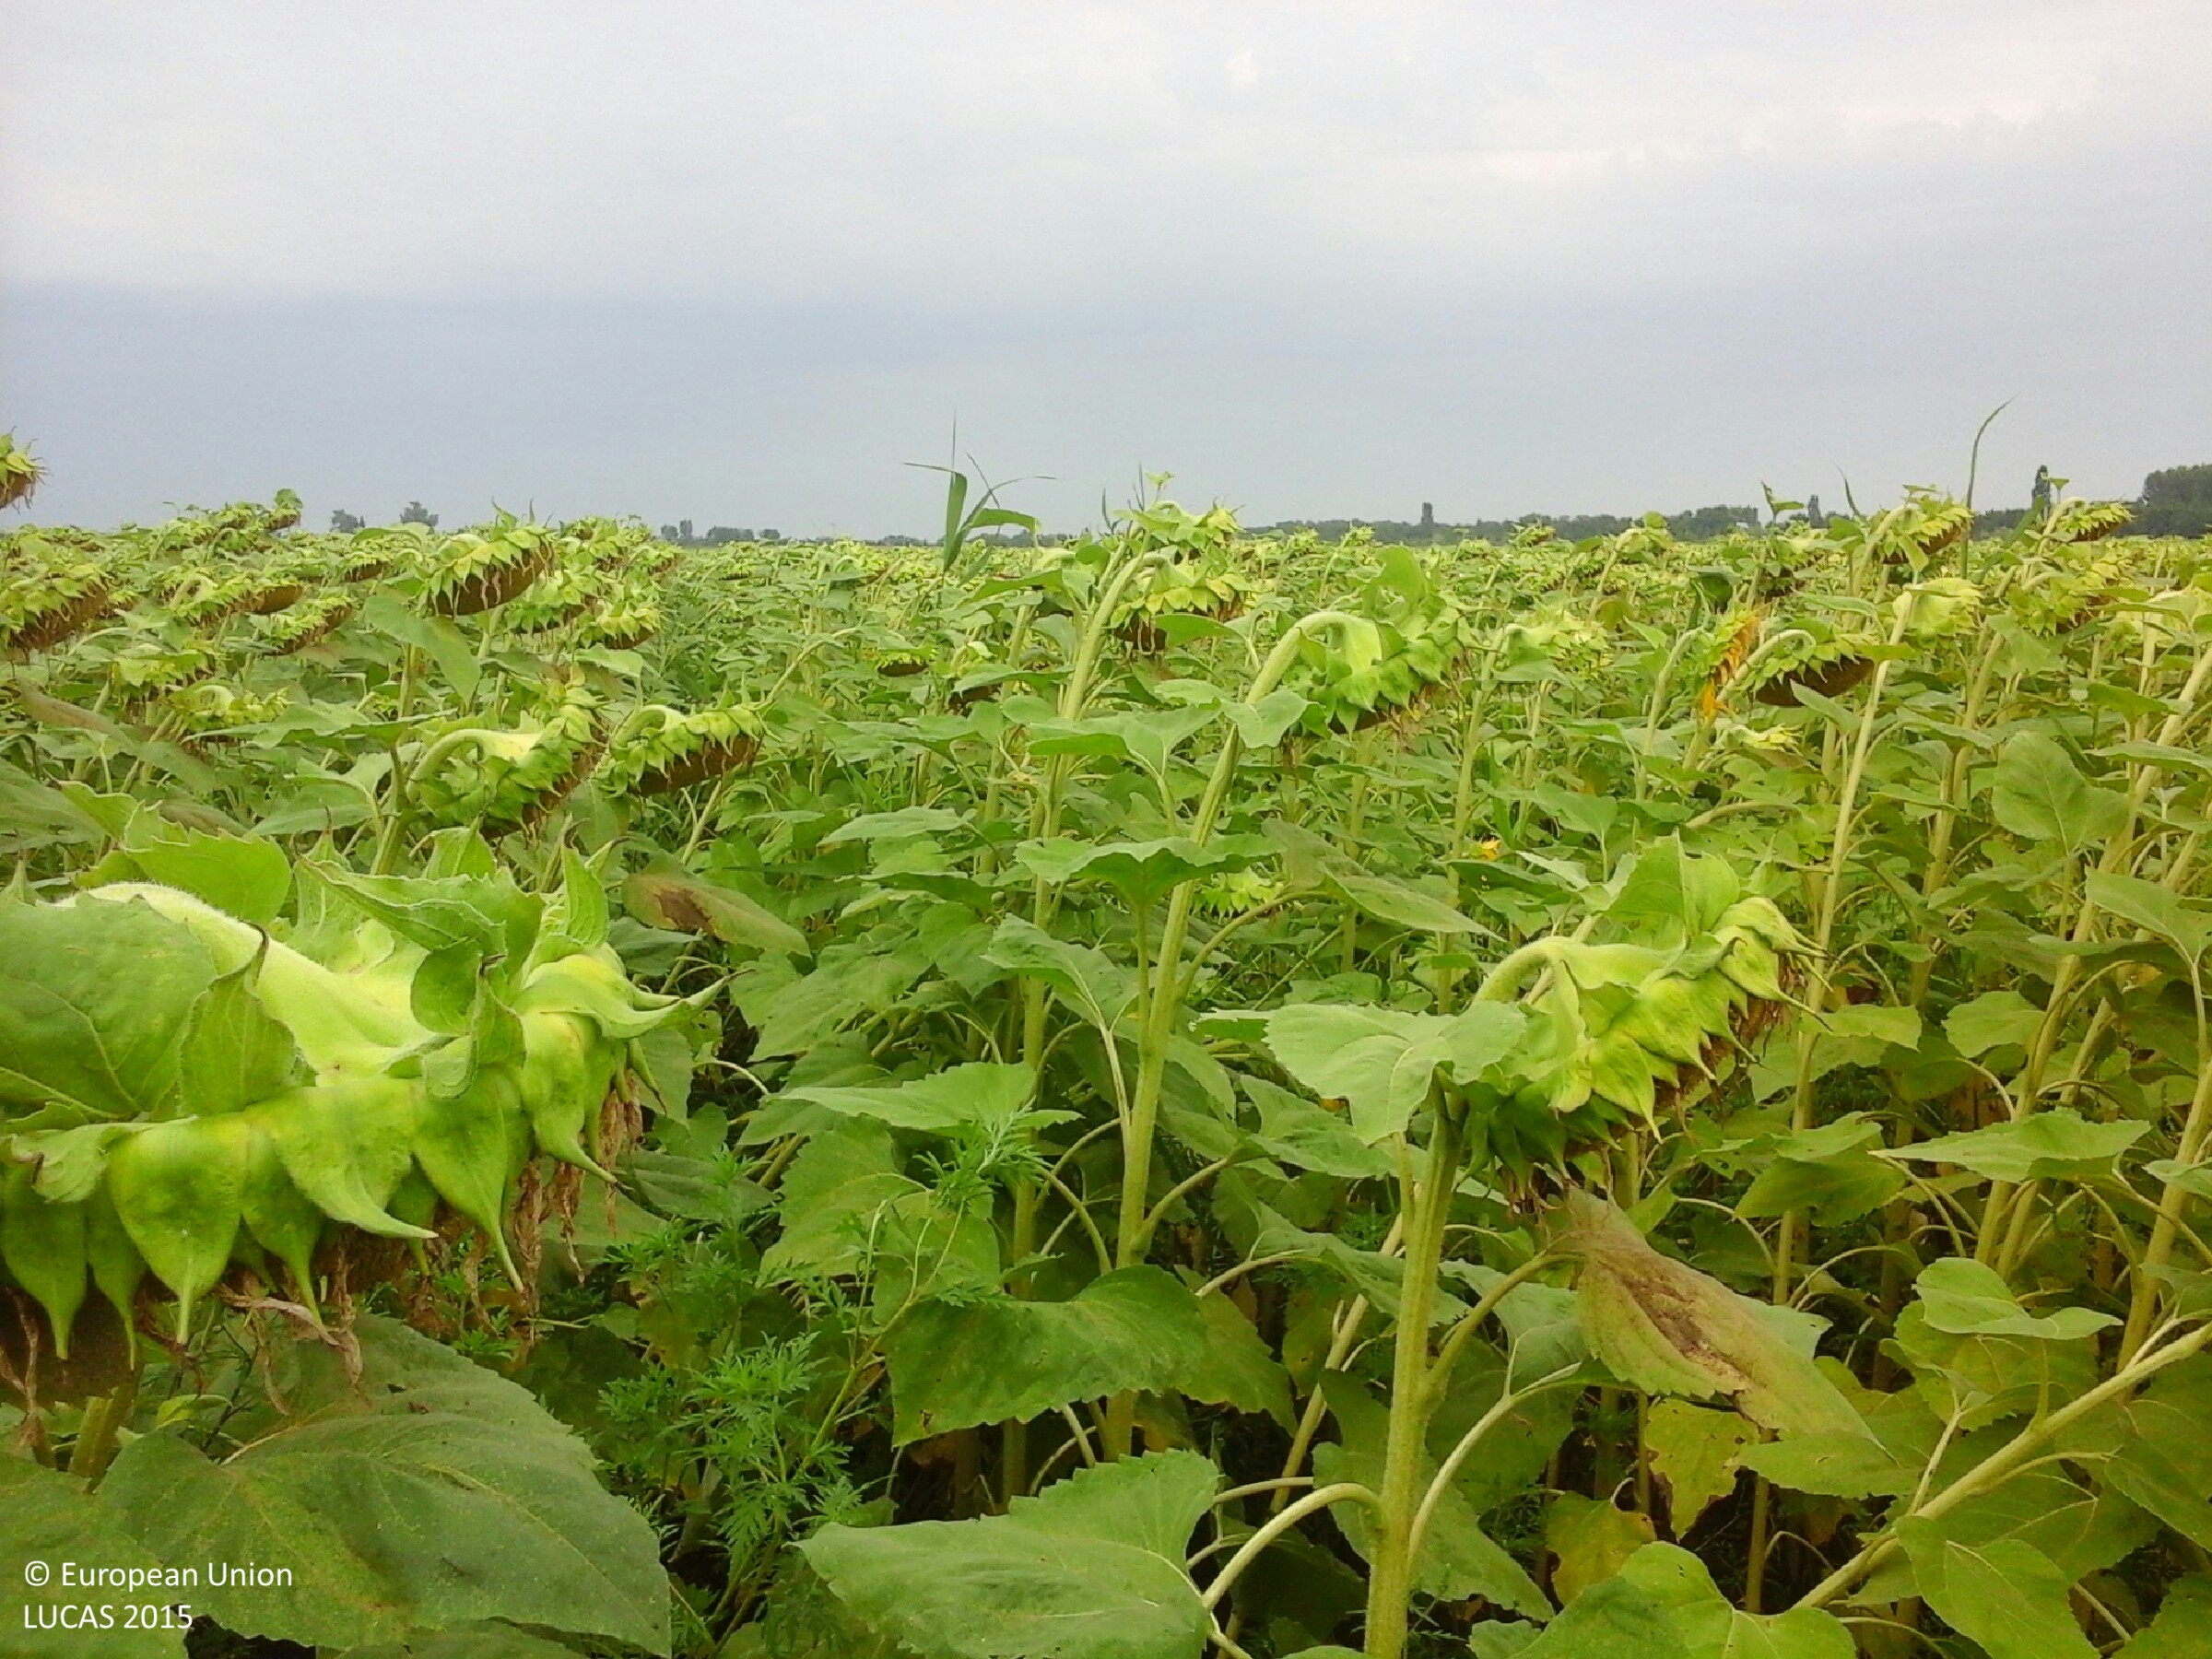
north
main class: Cropland
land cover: Sunflower
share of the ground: > 75 %
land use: Agriculture (excluding fallow land and kitchen gardens)
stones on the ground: < 10 %
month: August
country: HU
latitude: 47.5655
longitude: 20.7875
